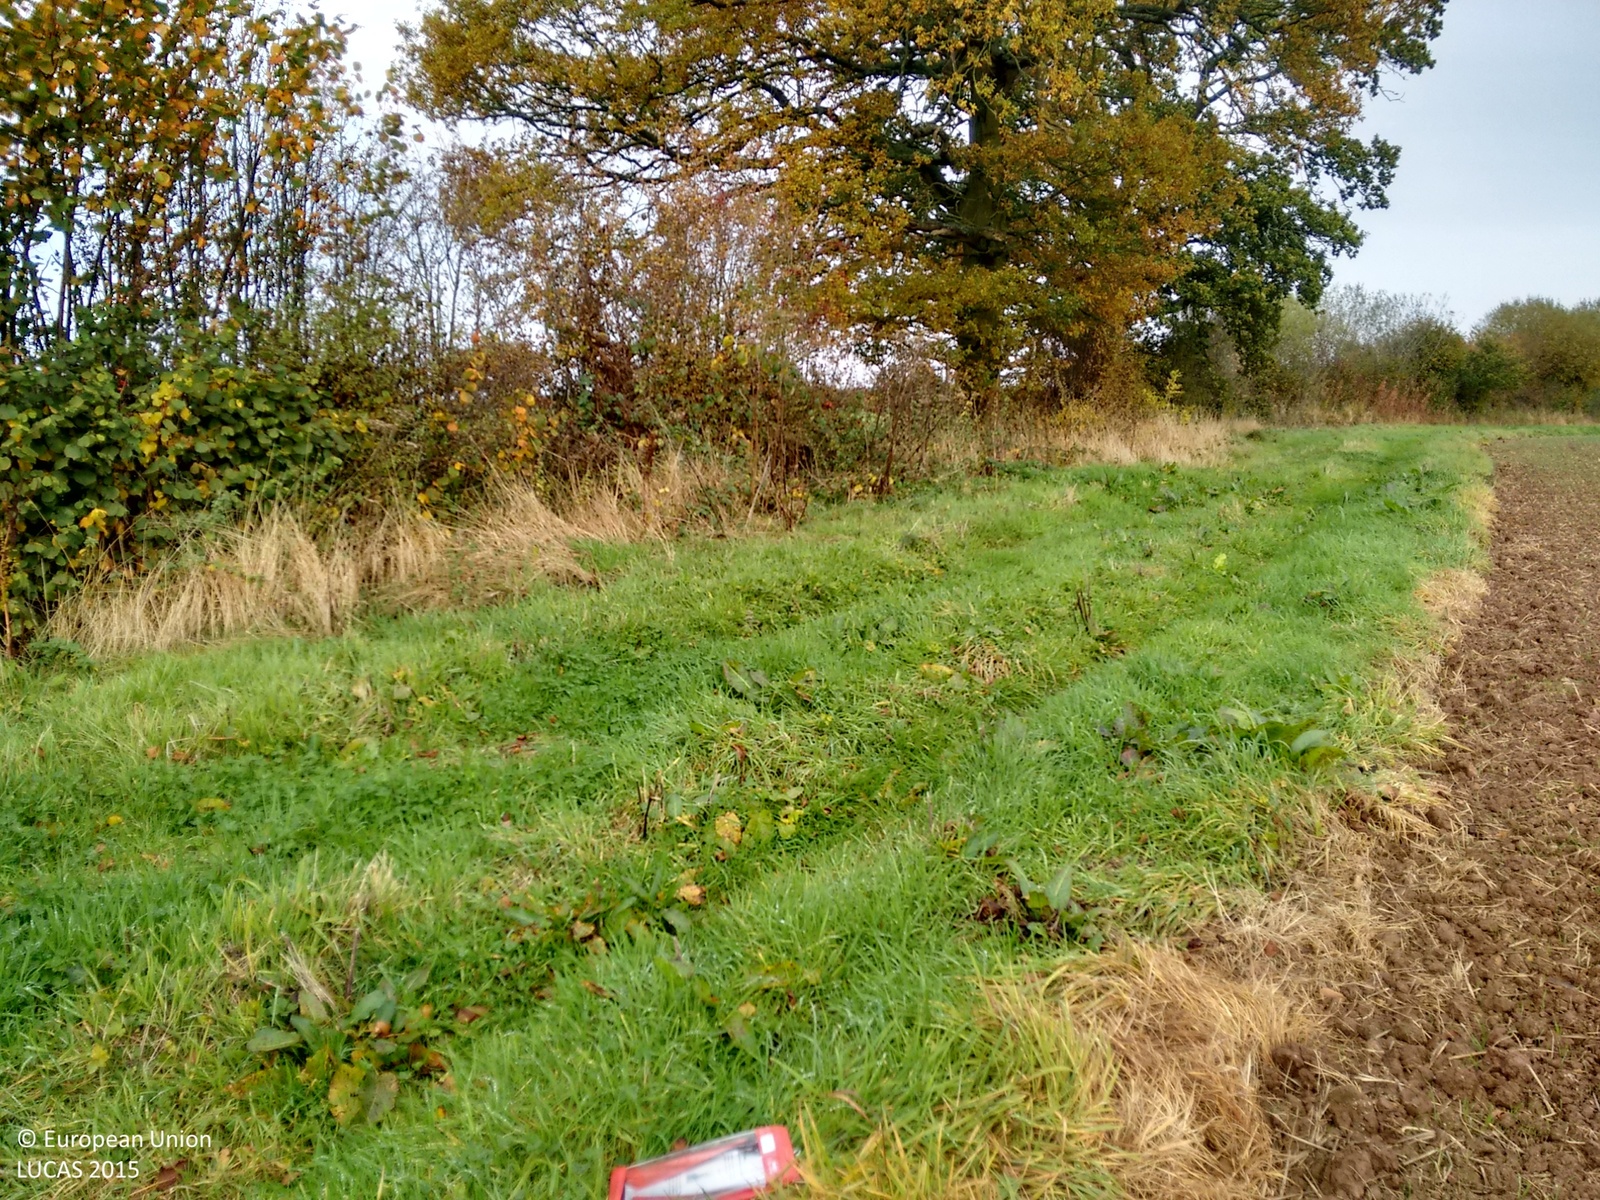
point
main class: Cropland
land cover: Common wheat
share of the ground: < 10 %
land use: Agriculture (excluding fallow land and kitchen gardens)
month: October
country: GB
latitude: 52.5094
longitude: -2.5467
